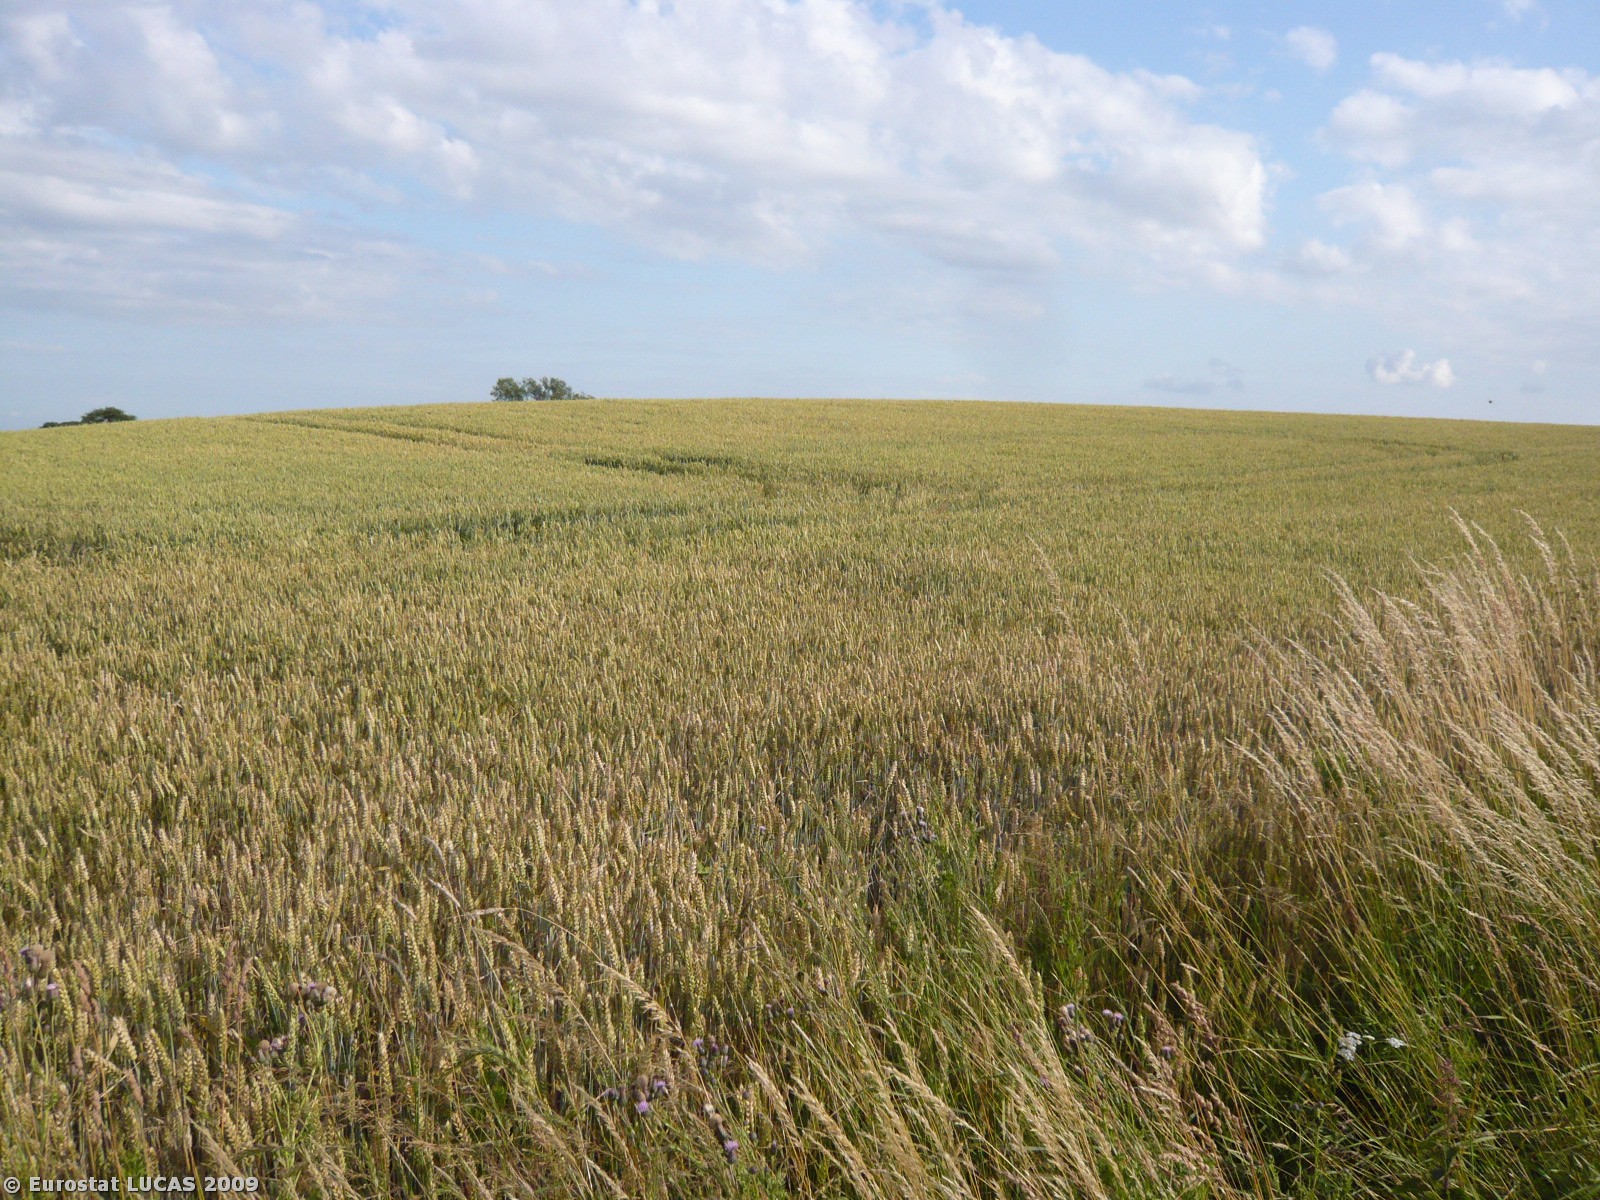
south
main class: Cropland
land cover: Common wheat
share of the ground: > 75 %
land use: Agriculture (excluding fallow land and kitchen gardens)
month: July
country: DK
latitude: 55.6036
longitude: 11.5065
